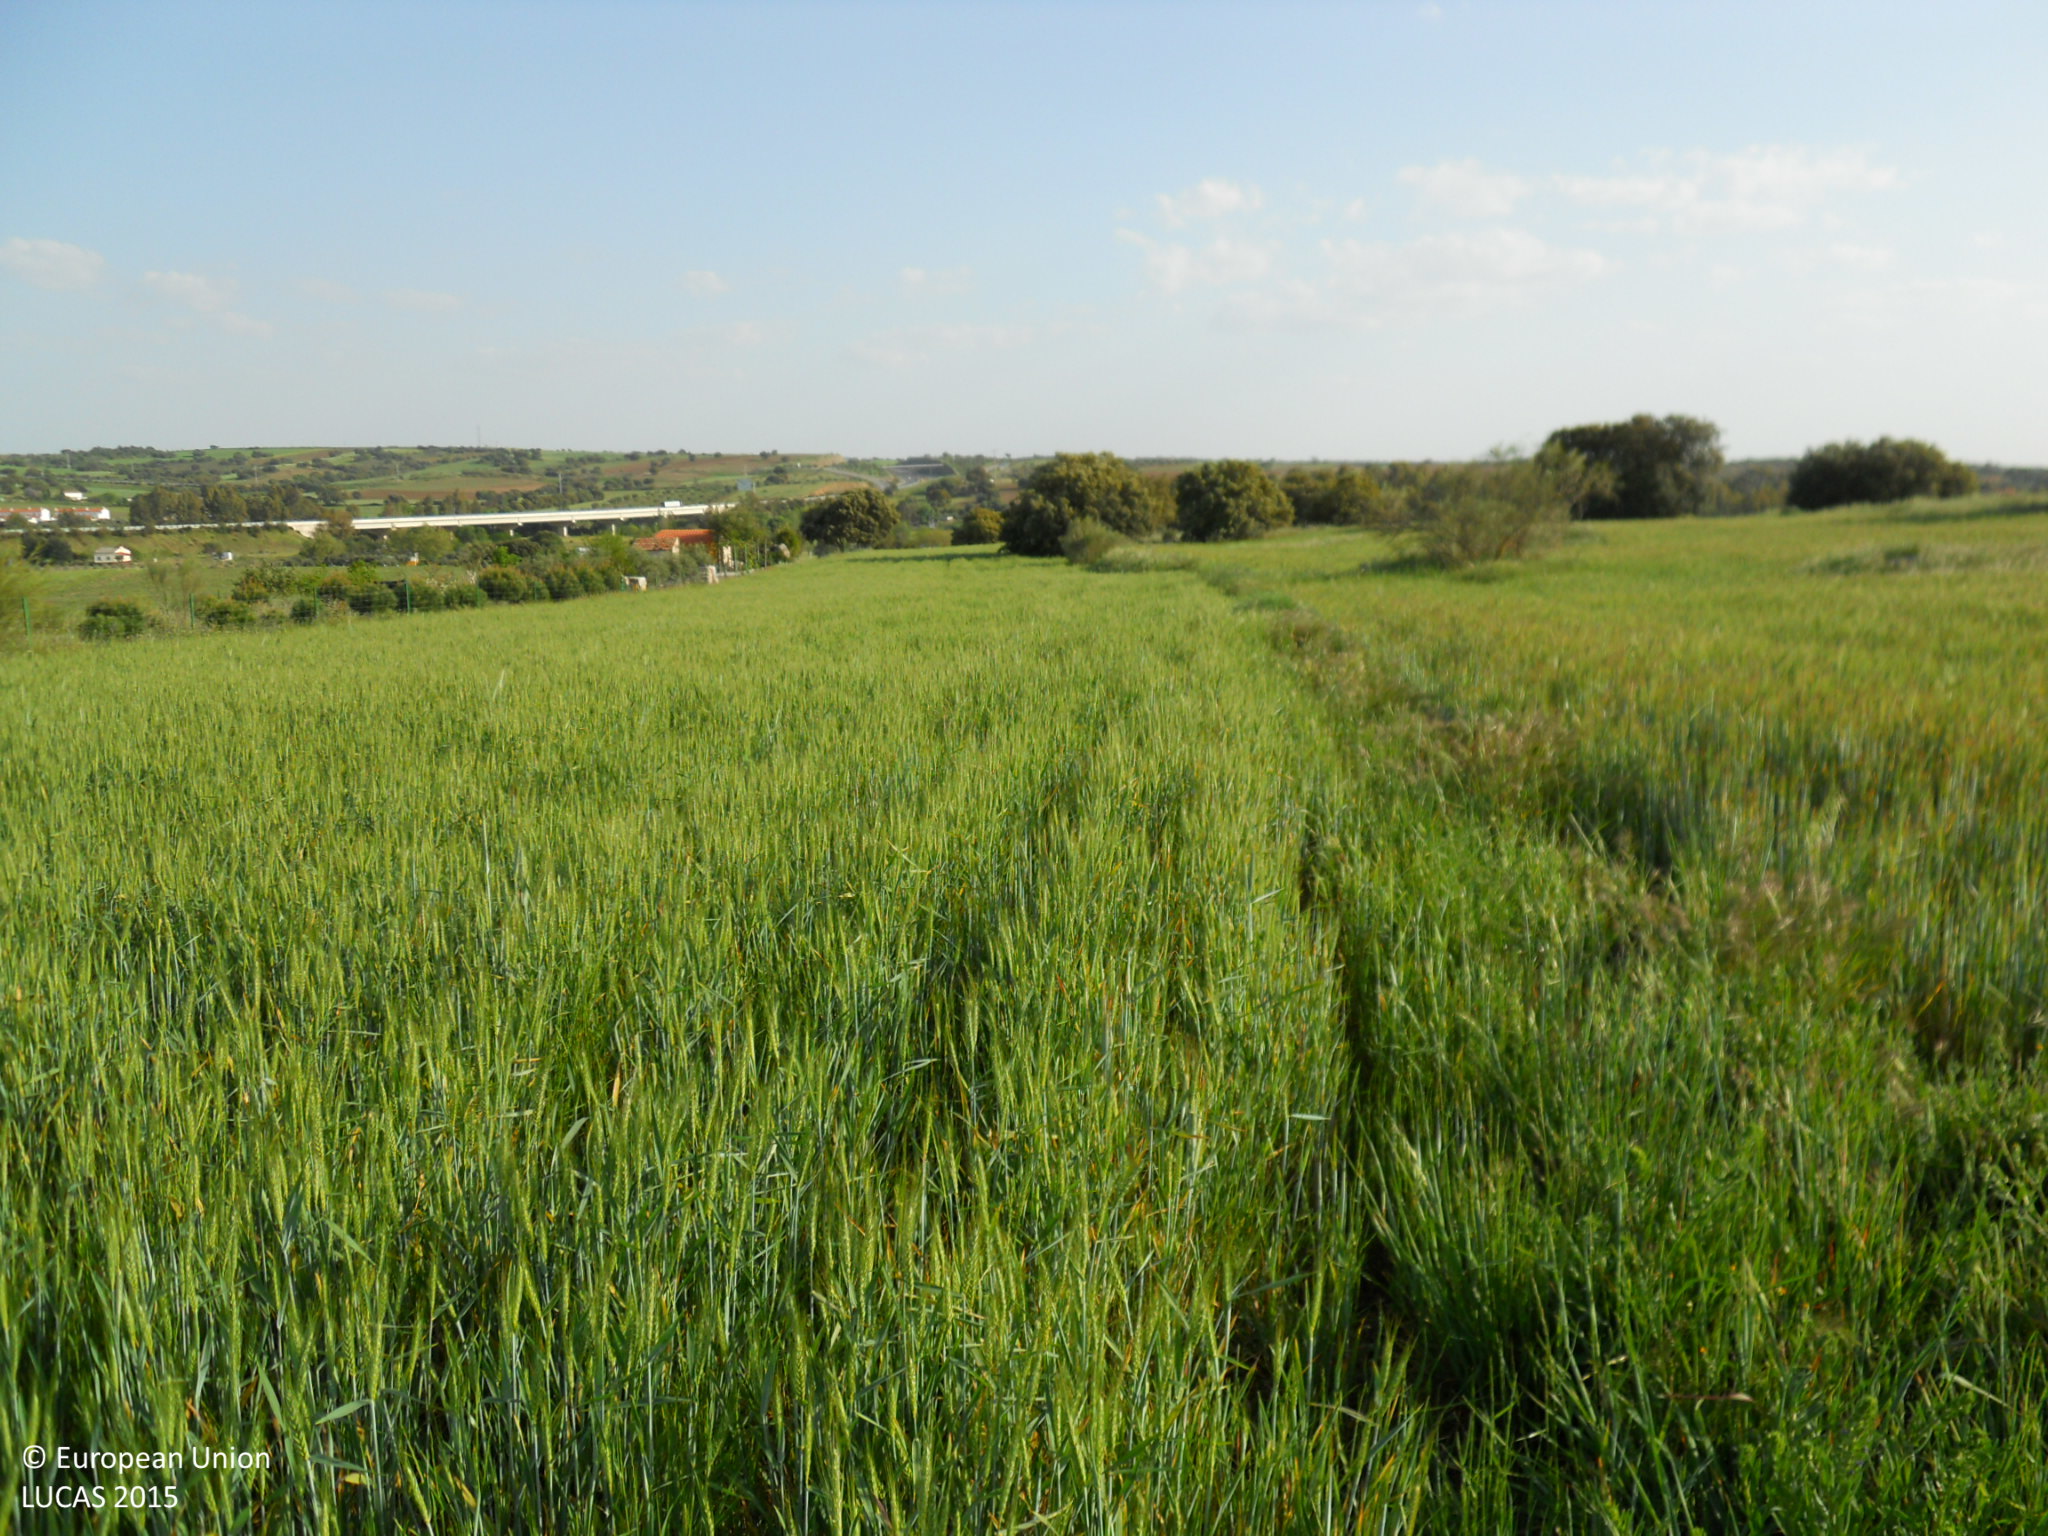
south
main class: Cropland
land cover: Barley
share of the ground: > 75 %
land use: Agriculture (excluding fallow land and kitchen gardens)
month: April
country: ES
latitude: 39.0525
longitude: -6.3414
